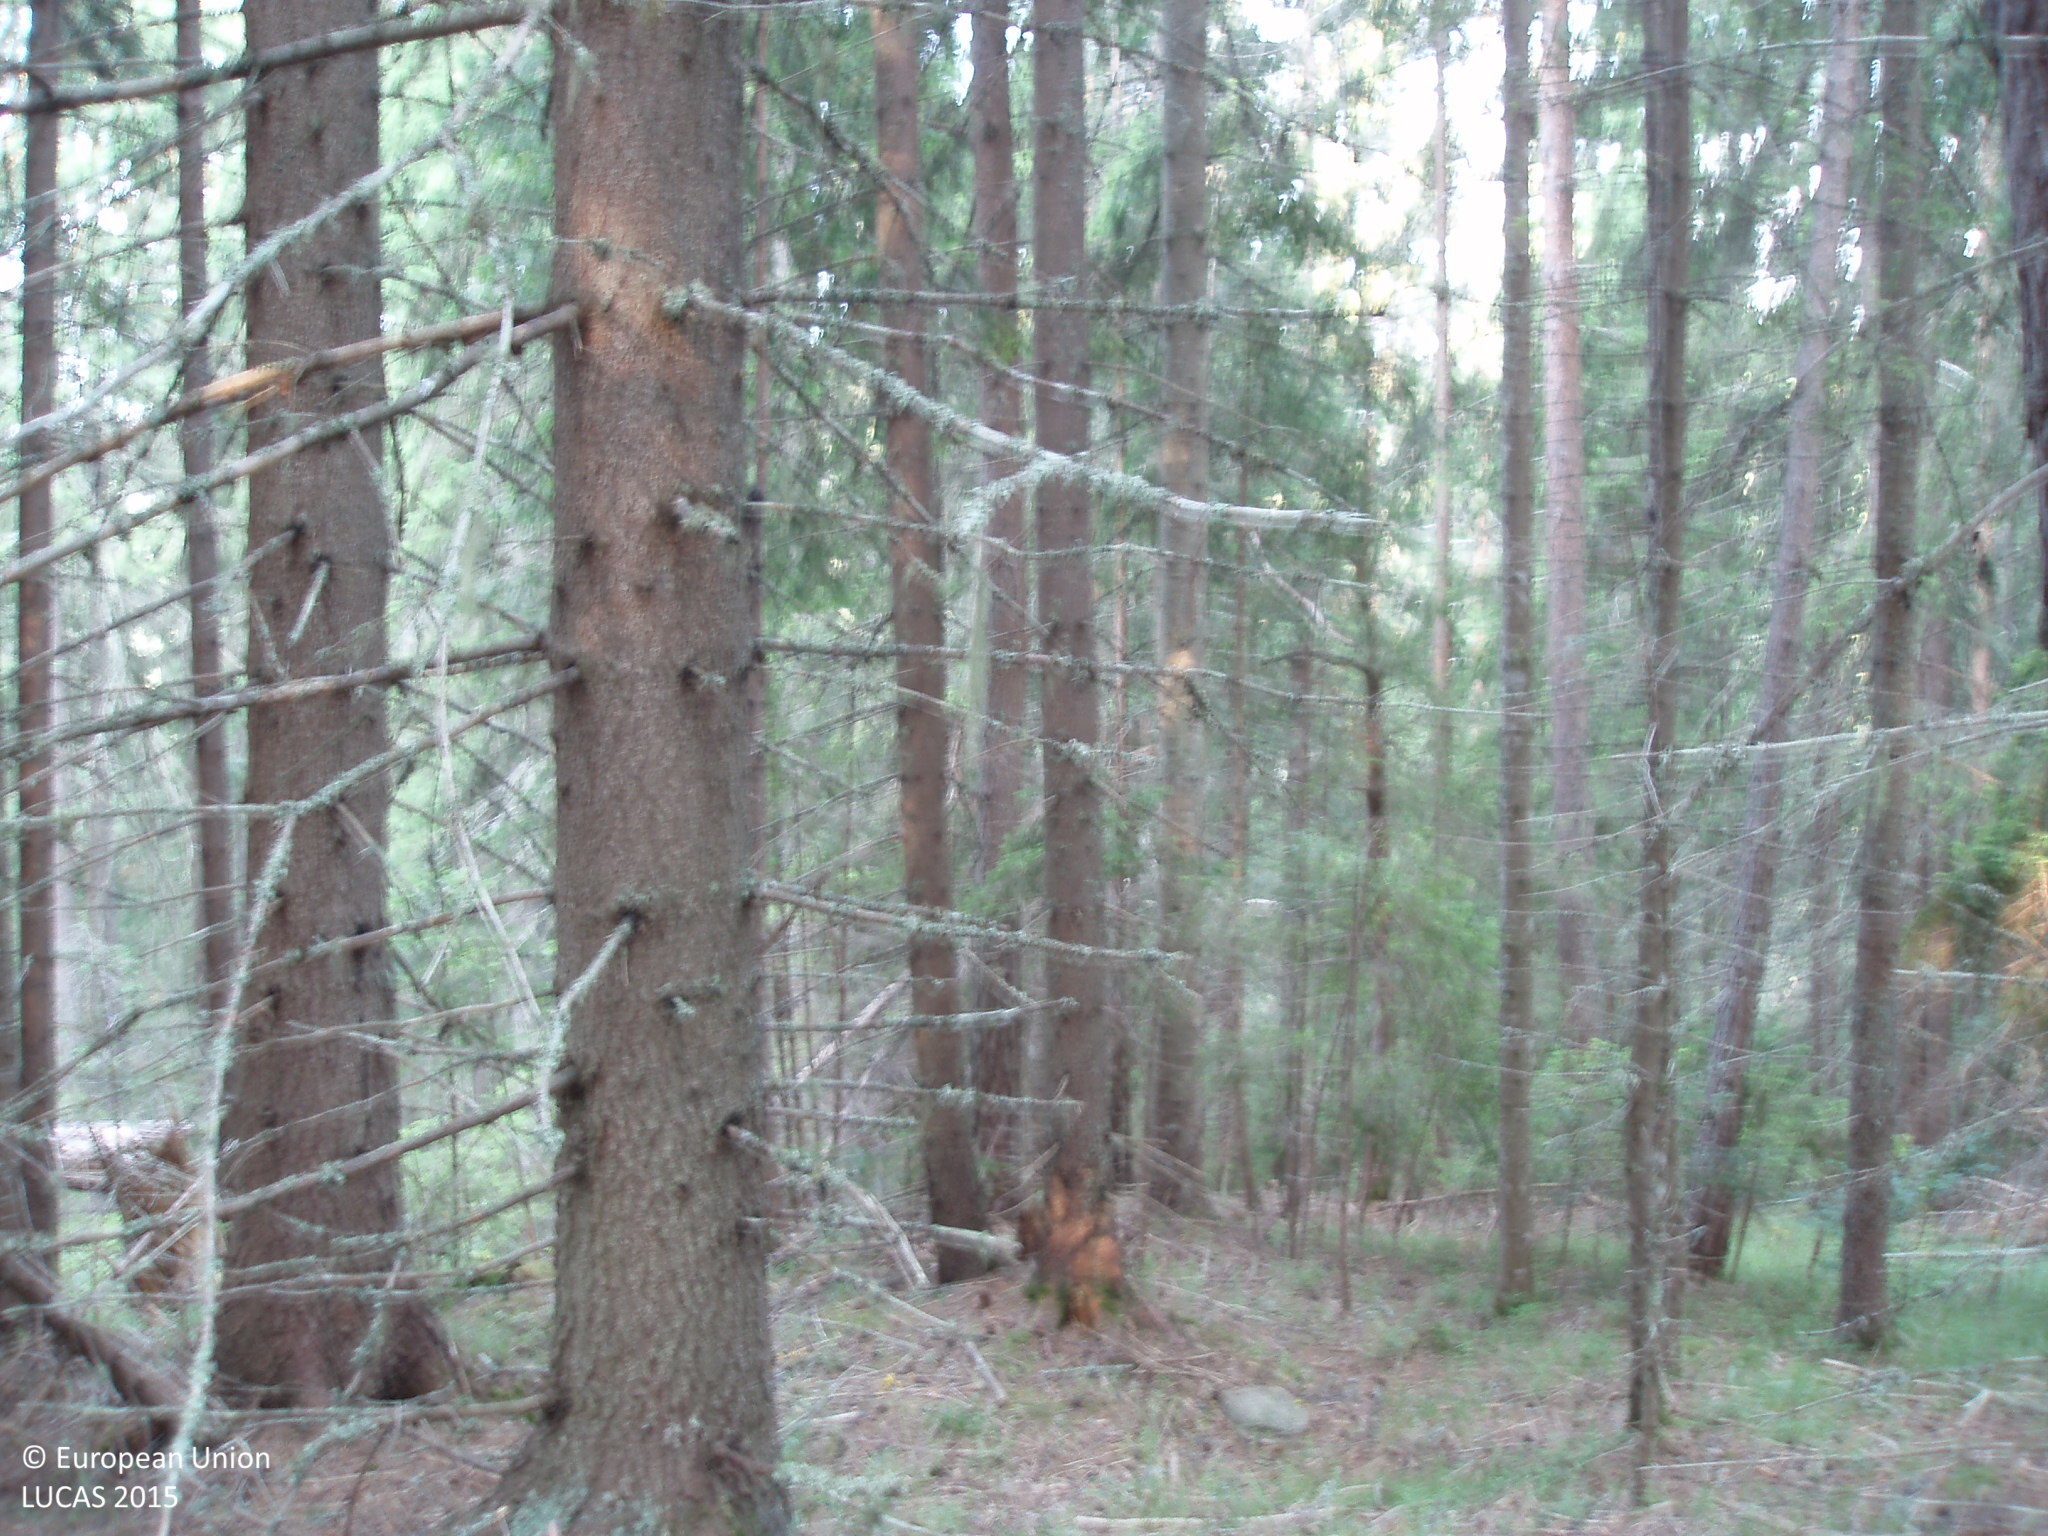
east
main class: Woodland
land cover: Spruce dominated coniferous woodland
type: hemiboreal forest and nemoral coniferous forest and mixed broadleaved-coniferous forest
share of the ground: > 75 %
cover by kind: coniferous forest trees 100 %
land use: Forestry
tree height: > 5 m
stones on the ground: 25 - 50 %
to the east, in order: Spruce dominated coniferous woodland
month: July
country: BG
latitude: 42.1010
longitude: 23.7098
